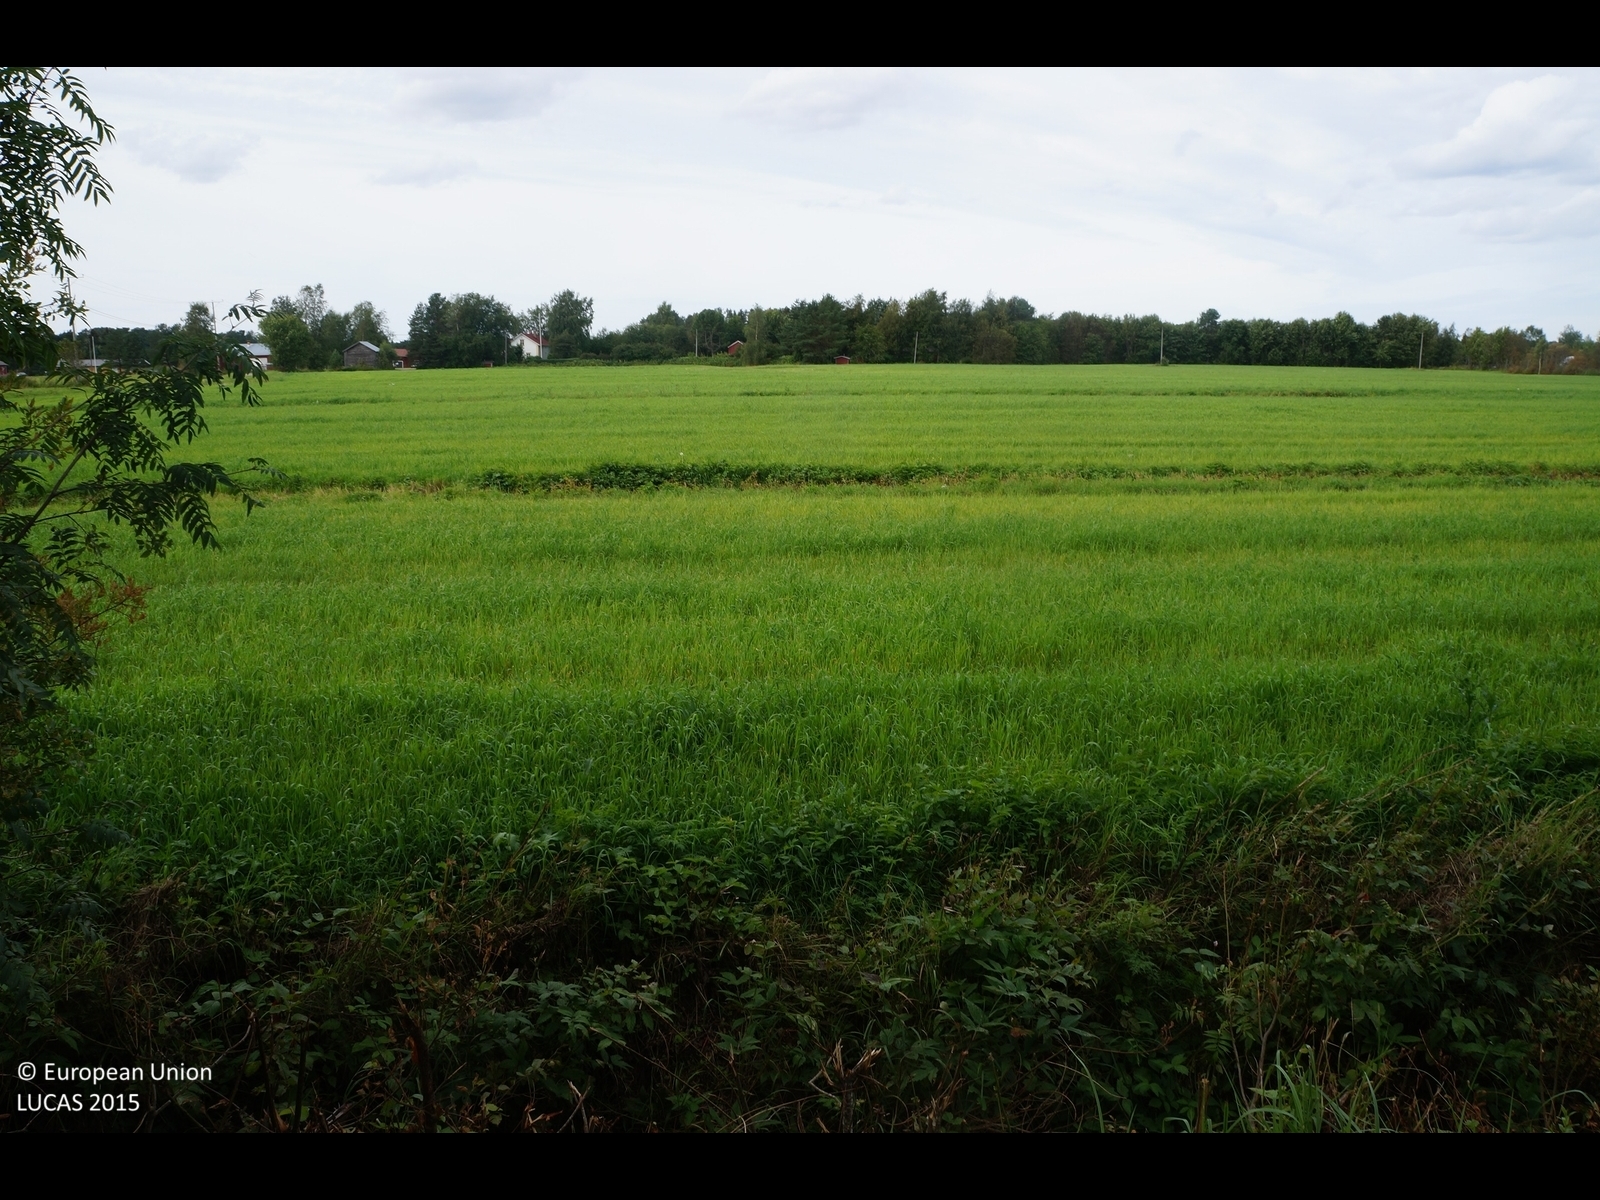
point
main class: Cropland
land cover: Temporary grasslands
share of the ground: > 75 %
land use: Agriculture (excluding fallow land and kitchen gardens)
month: August
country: FI
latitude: 64.8284
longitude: 24.7572
